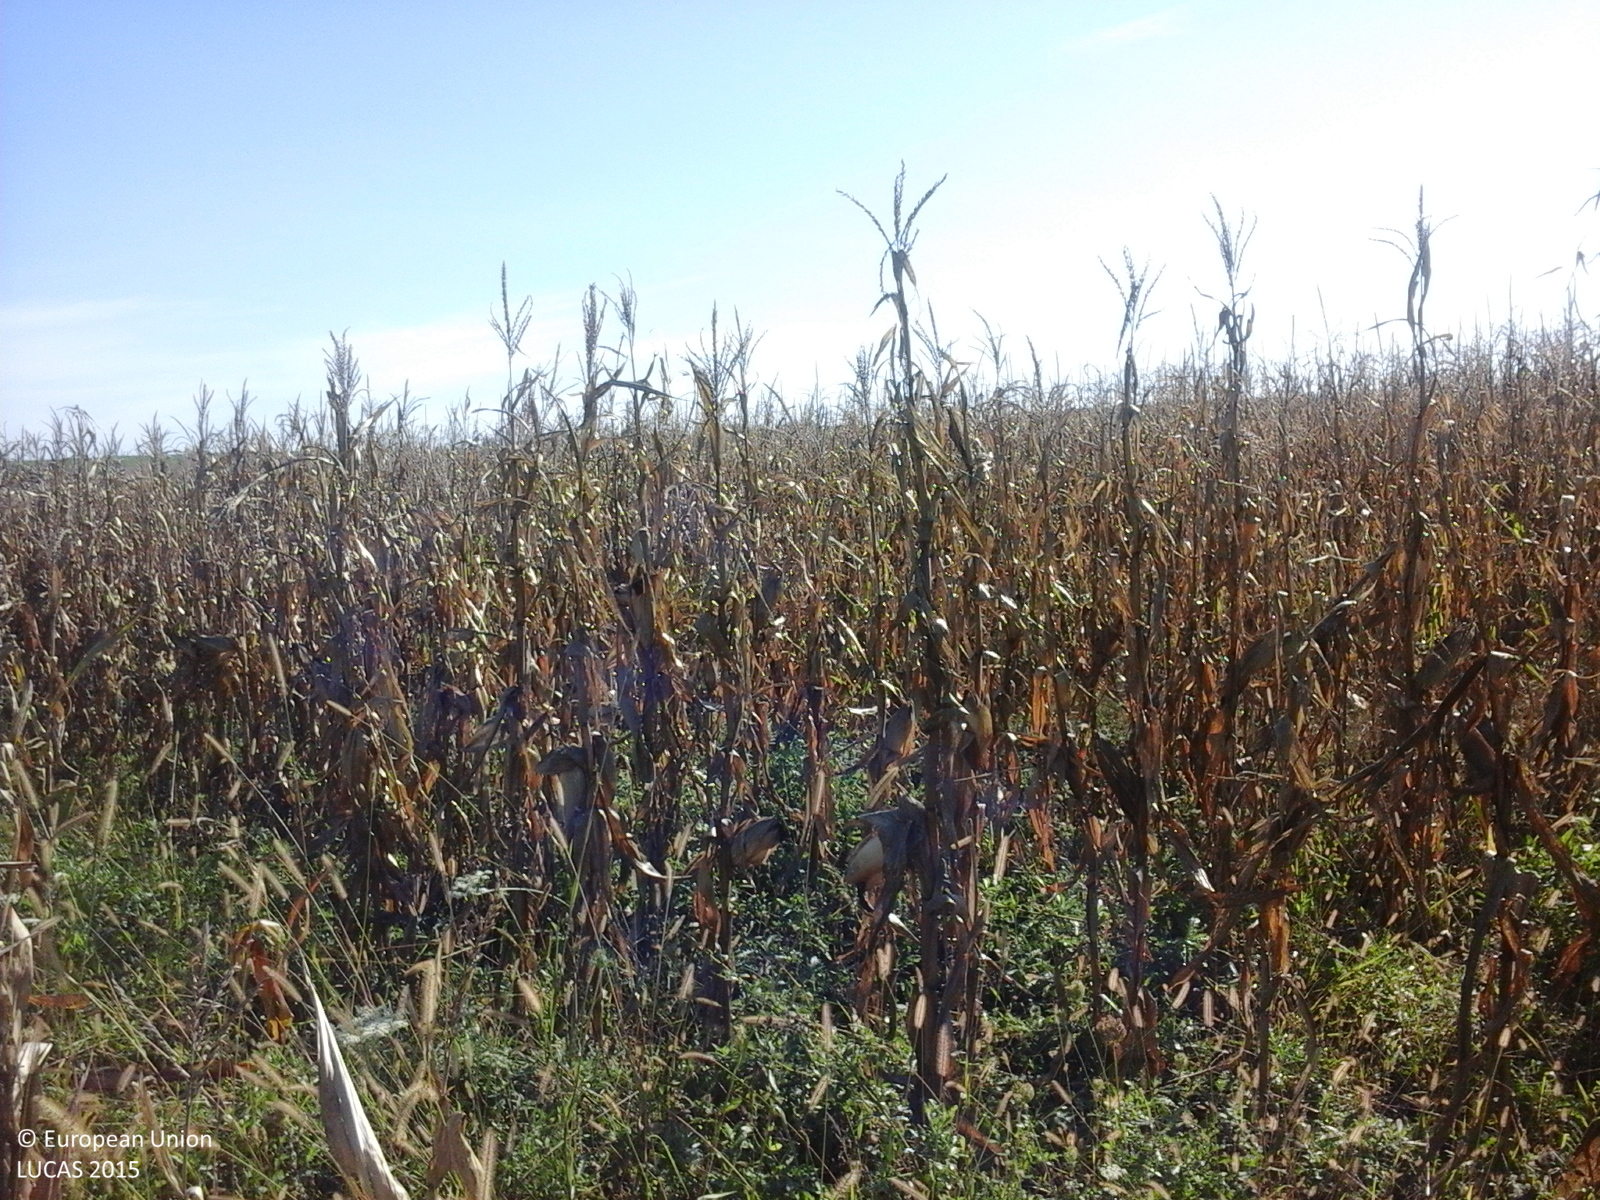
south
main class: Cropland
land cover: Maize
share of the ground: > 75 %
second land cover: Spontaneously vegetated surfaces
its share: > 75 %
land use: Agriculture (excluding fallow land and kitchen gardens)
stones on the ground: < 10 %
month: October
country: RO
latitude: 46.1479
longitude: 23.7813
